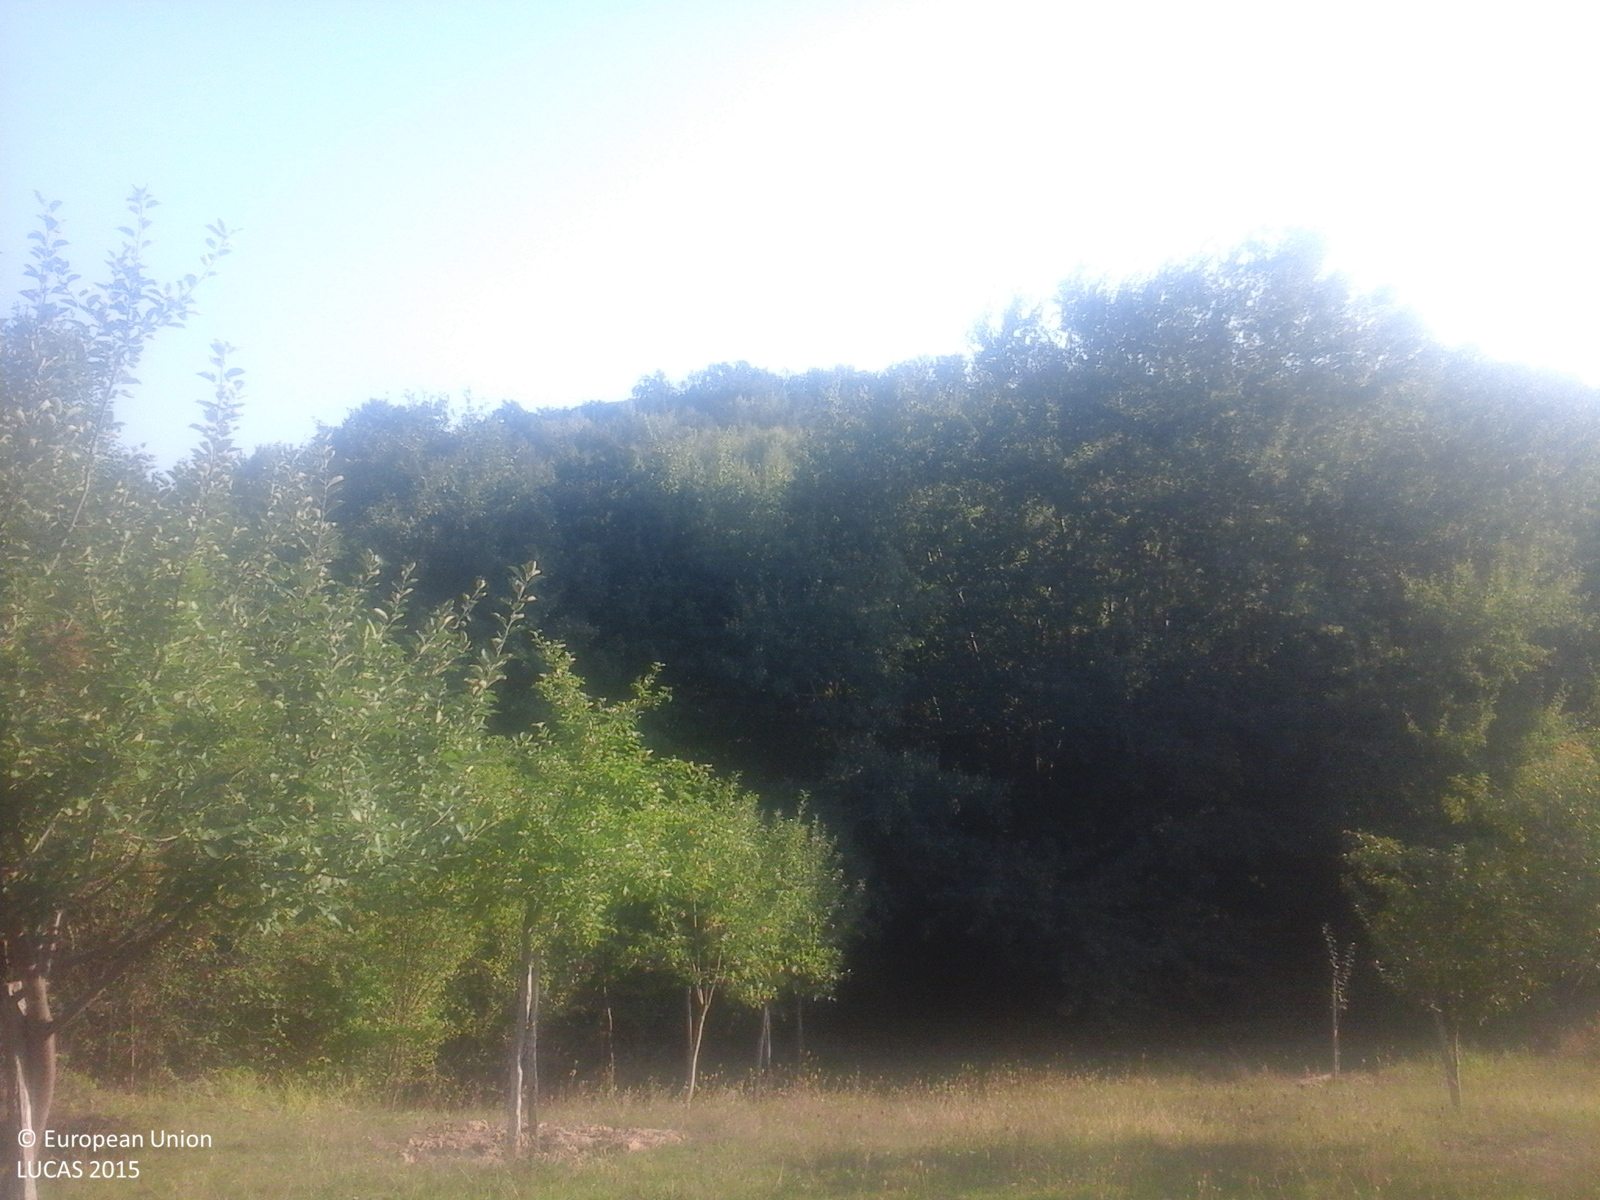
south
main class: Cropland
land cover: Apple fruit
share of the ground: 10 - 25 %
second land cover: Grassland without tree/shrub cover
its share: > 75 %
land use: Agriculture (excluding fallow land and kitchen gardens)
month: September
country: RO
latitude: 46.6172
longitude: 22.3376
